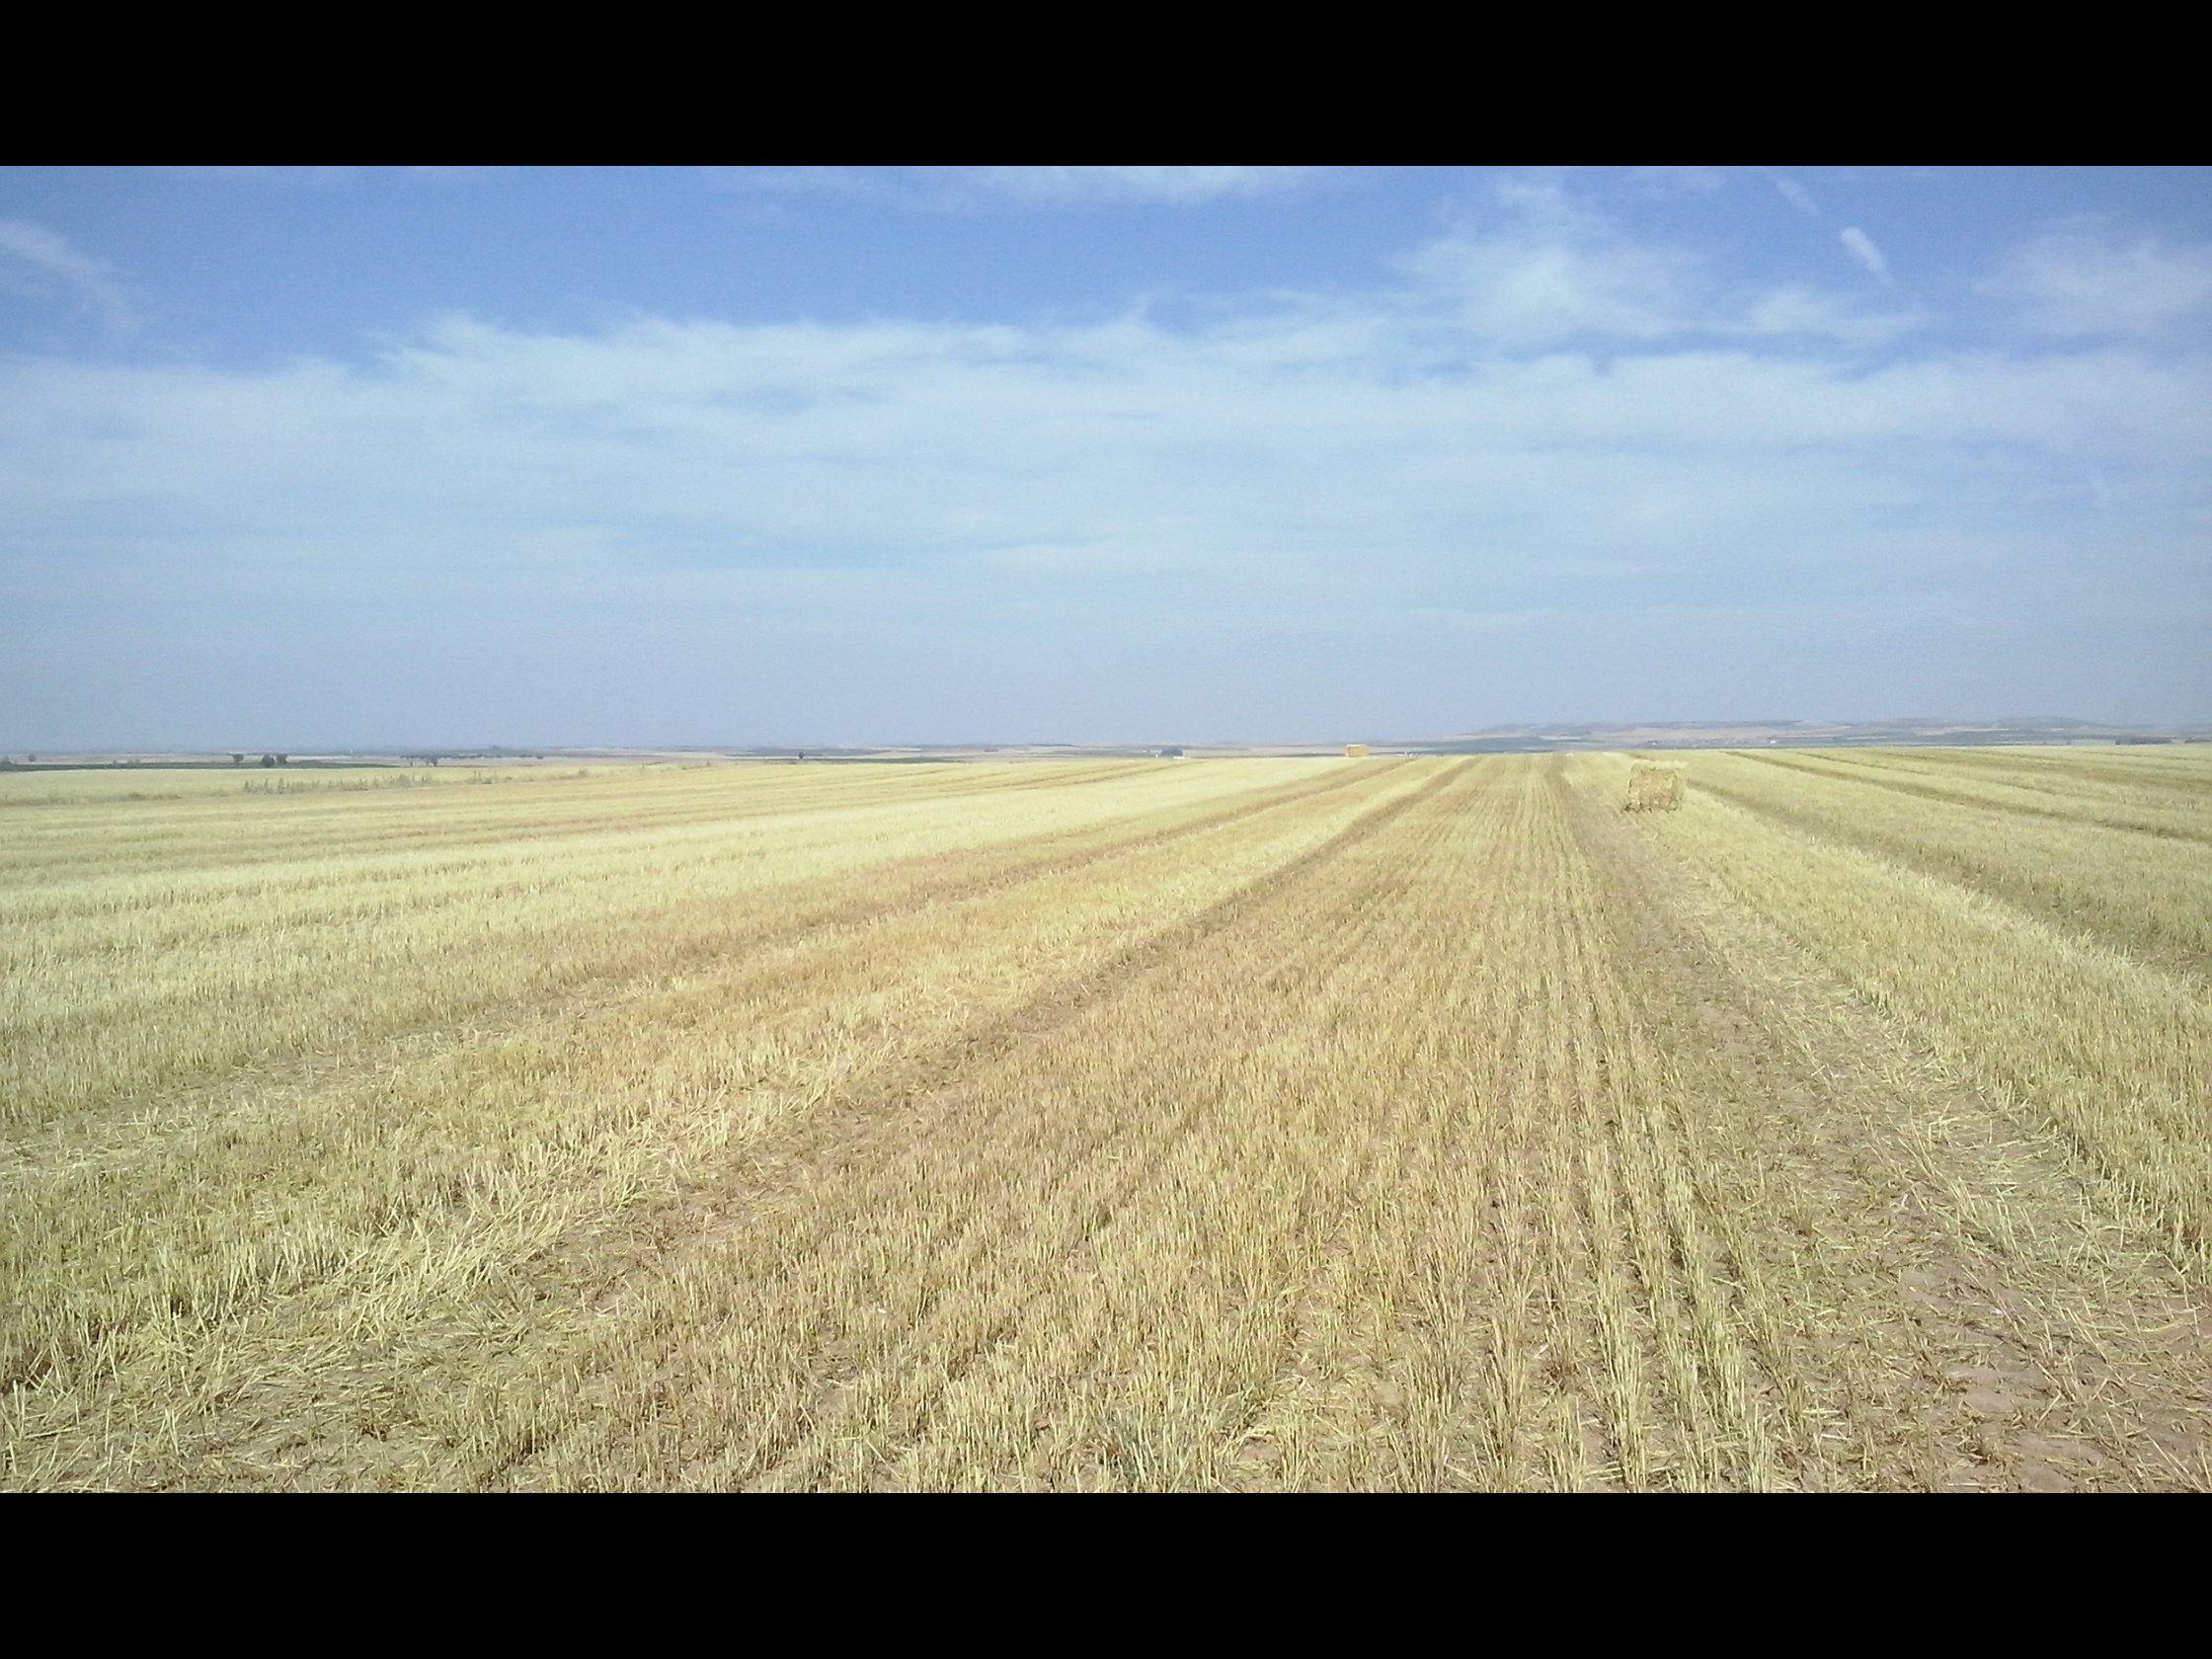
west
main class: Cropland
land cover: Barley
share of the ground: < 10 %
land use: Agriculture (excluding fallow land and kitchen gardens)
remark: Harvested field
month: July
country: ES
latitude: 41.5304
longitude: -5.1158
